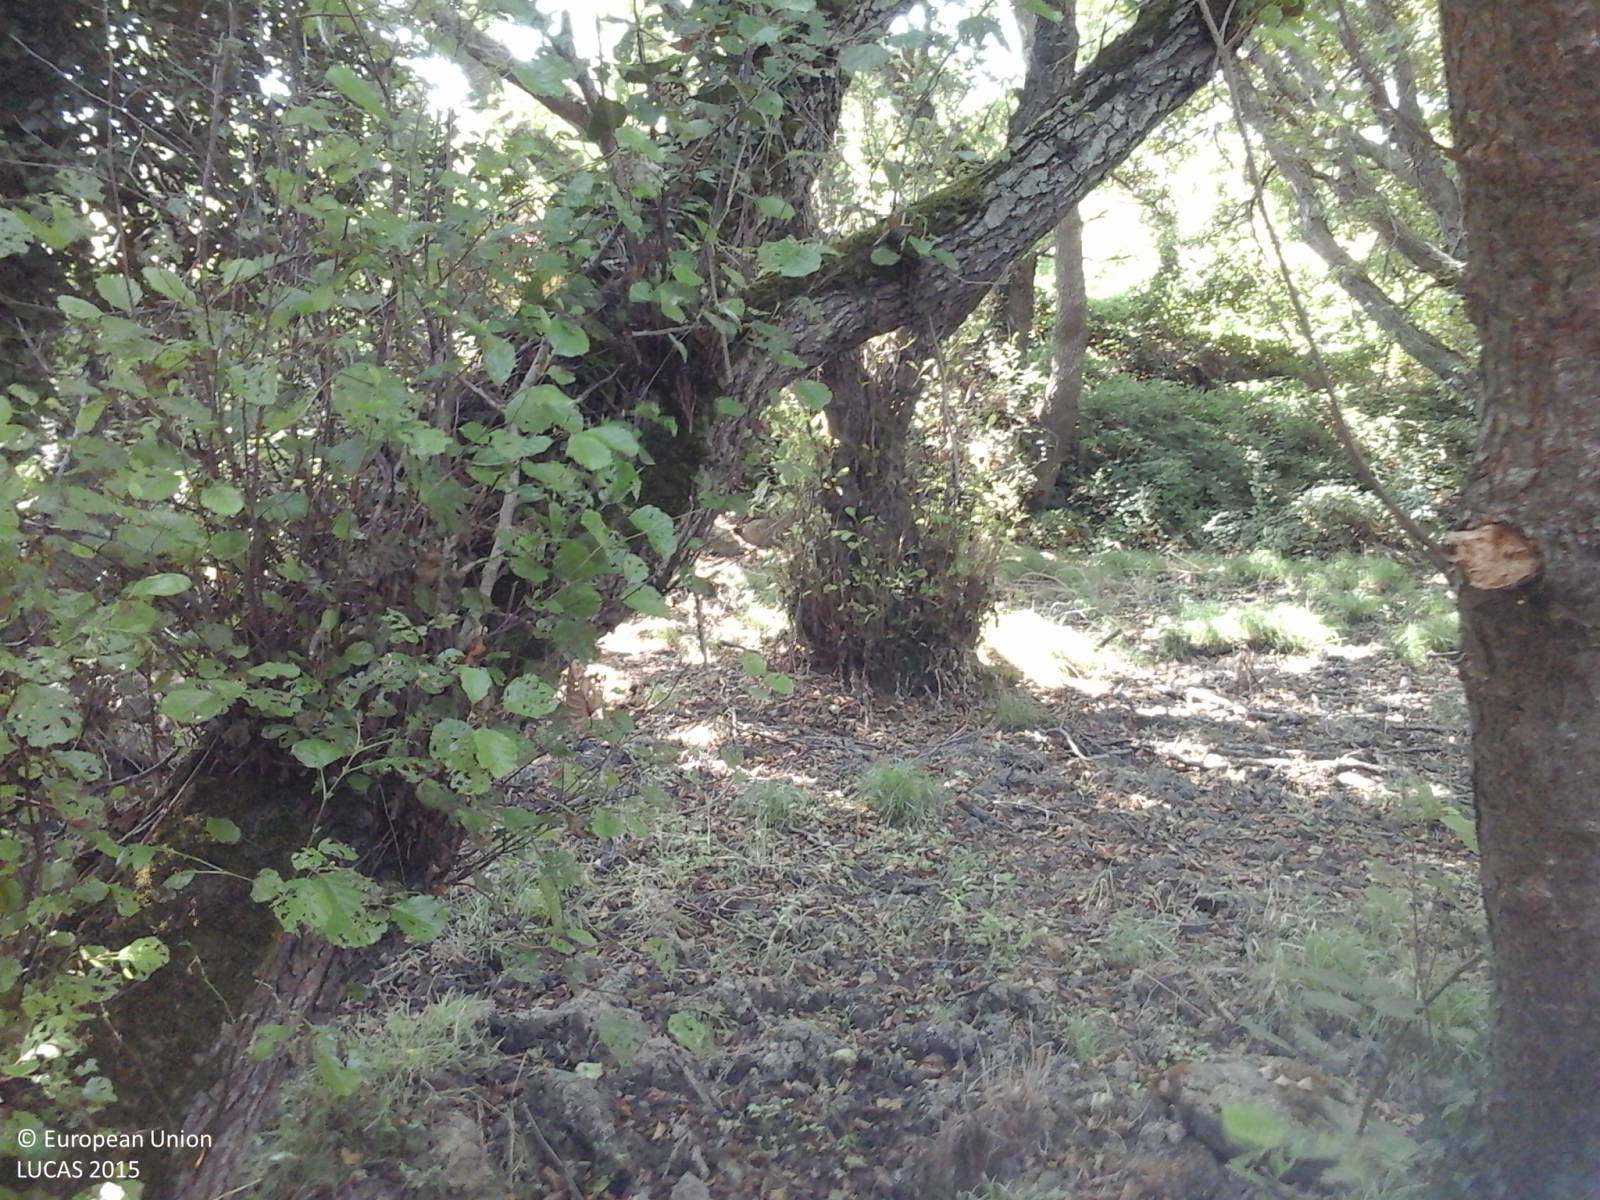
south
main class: Woodland
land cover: Broadleaved woodland
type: acidophilous oak and oak-birch forest
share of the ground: 10 - 25 %
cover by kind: unconsolidated bare surface 50 %, herbaceous plants 25 %, shrubs 15 %, broadleaved forest trees 10 %
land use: Semi-natural and natural areas not in use
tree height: > 5 m
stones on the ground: < 10 %
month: August
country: IT
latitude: 40.9876
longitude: 9.1600
